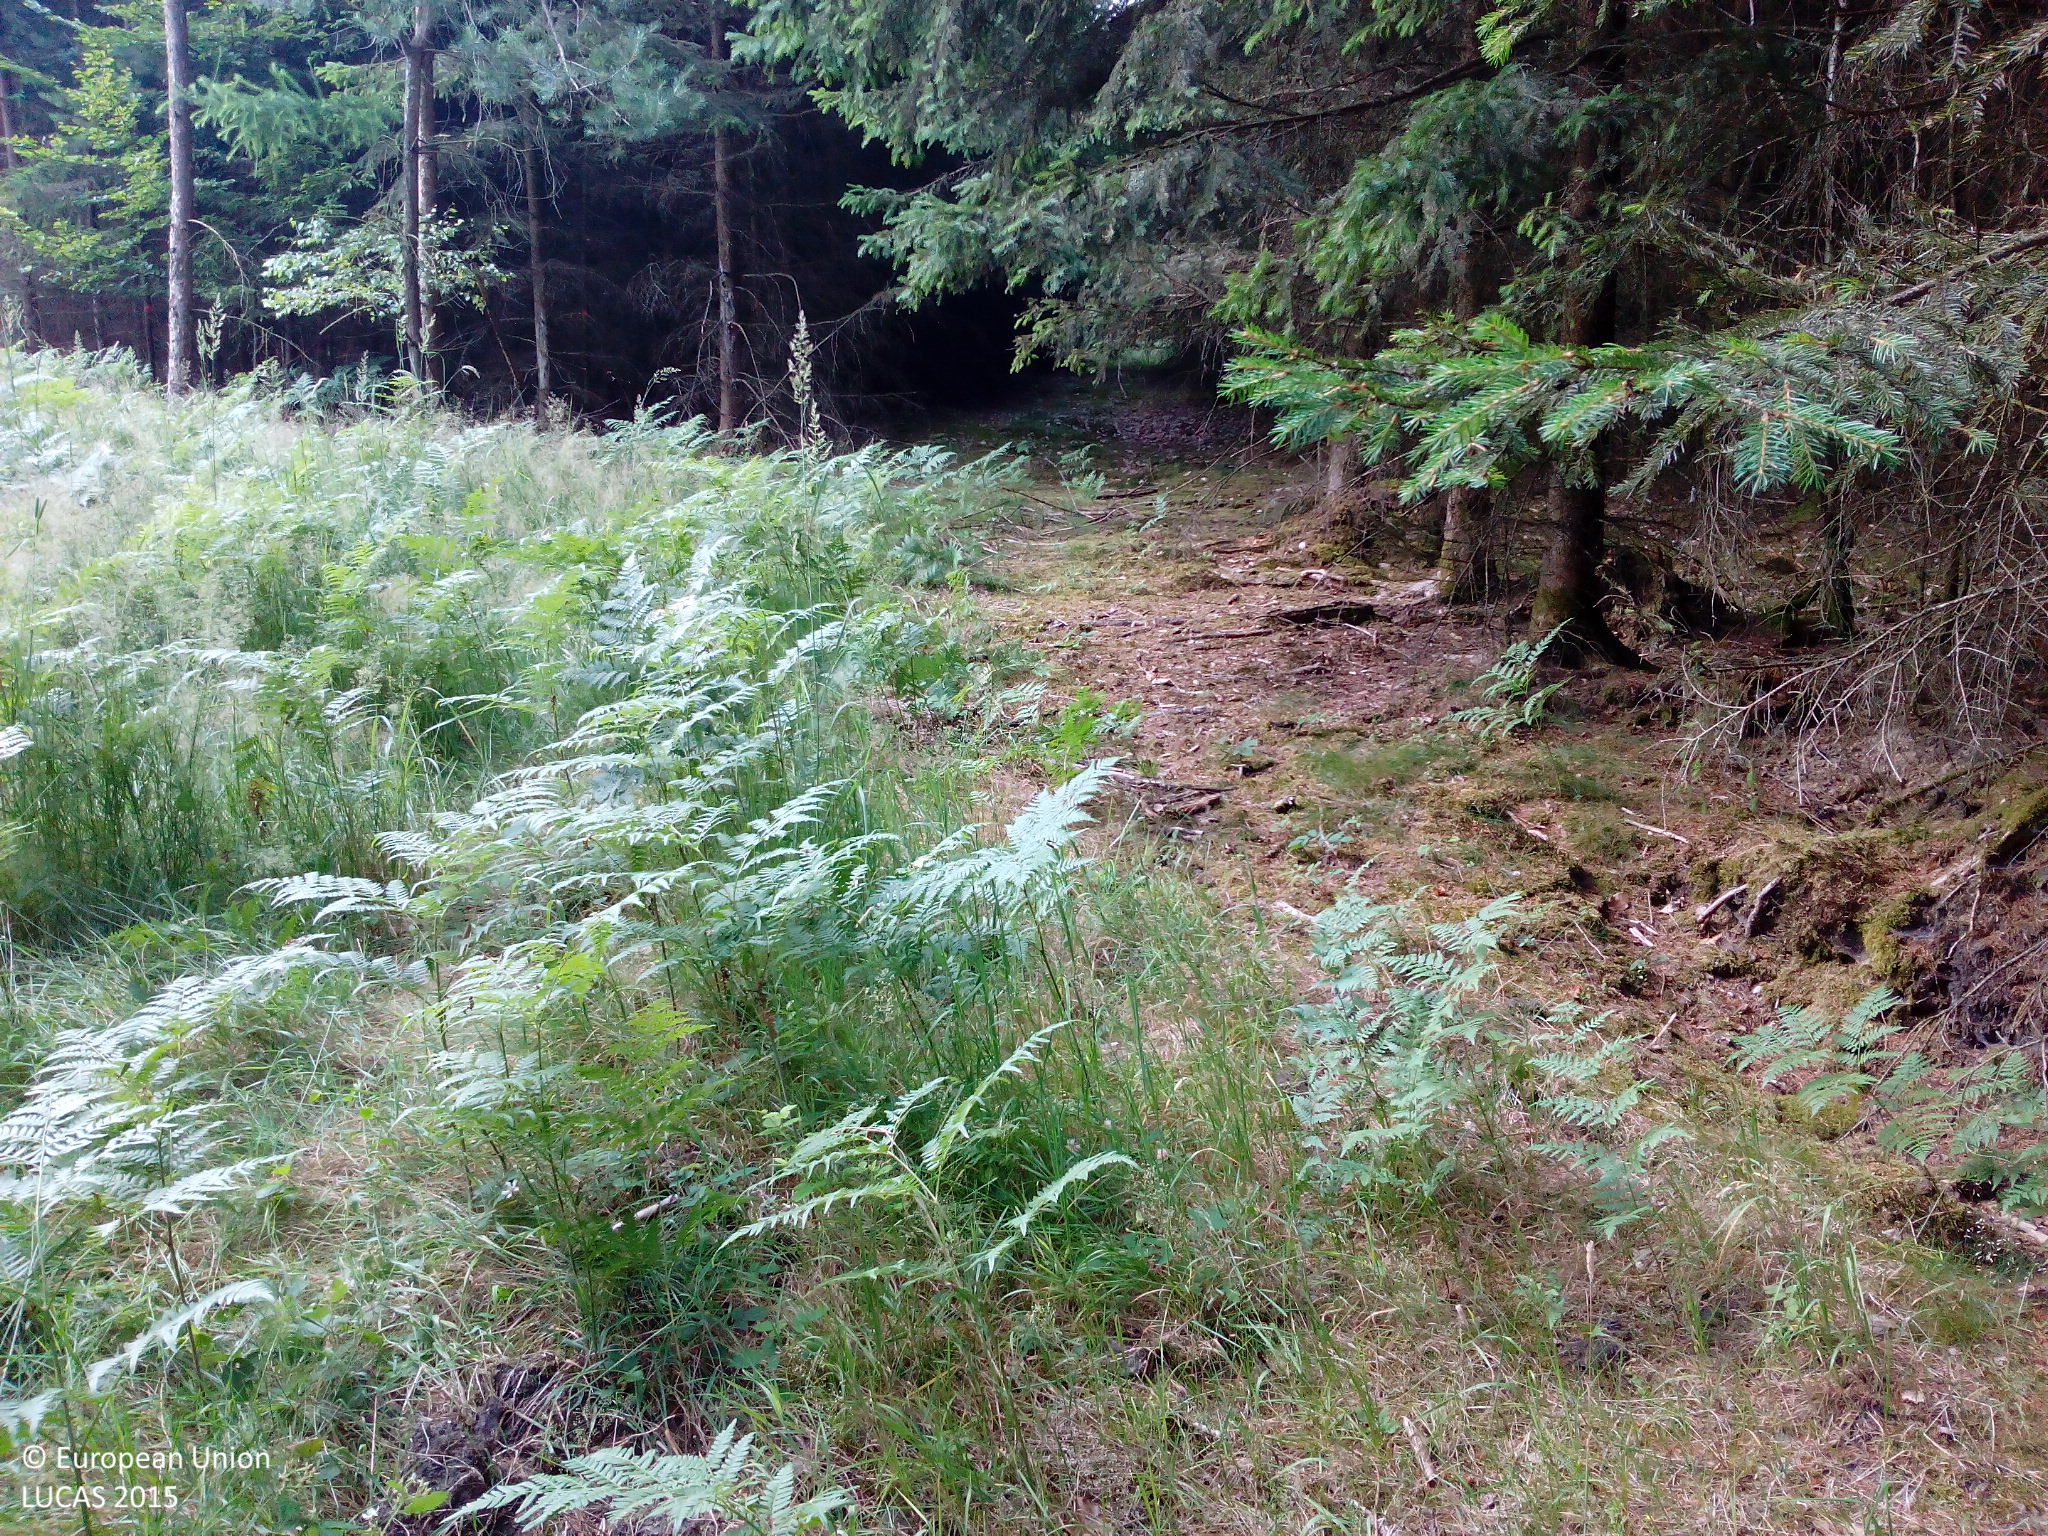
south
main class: Woodland
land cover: Spruce dominated coniferous woodland
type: hemiboreal forest and nemoral coniferous forest and mixed broadleaved-coniferous forest
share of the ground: > 75 %
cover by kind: coniferous forest trees 95 %, consolidated bare surface 5 %
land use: Forestry
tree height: > 5 m
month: July
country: DE
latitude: 48.9057
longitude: 12.0867
